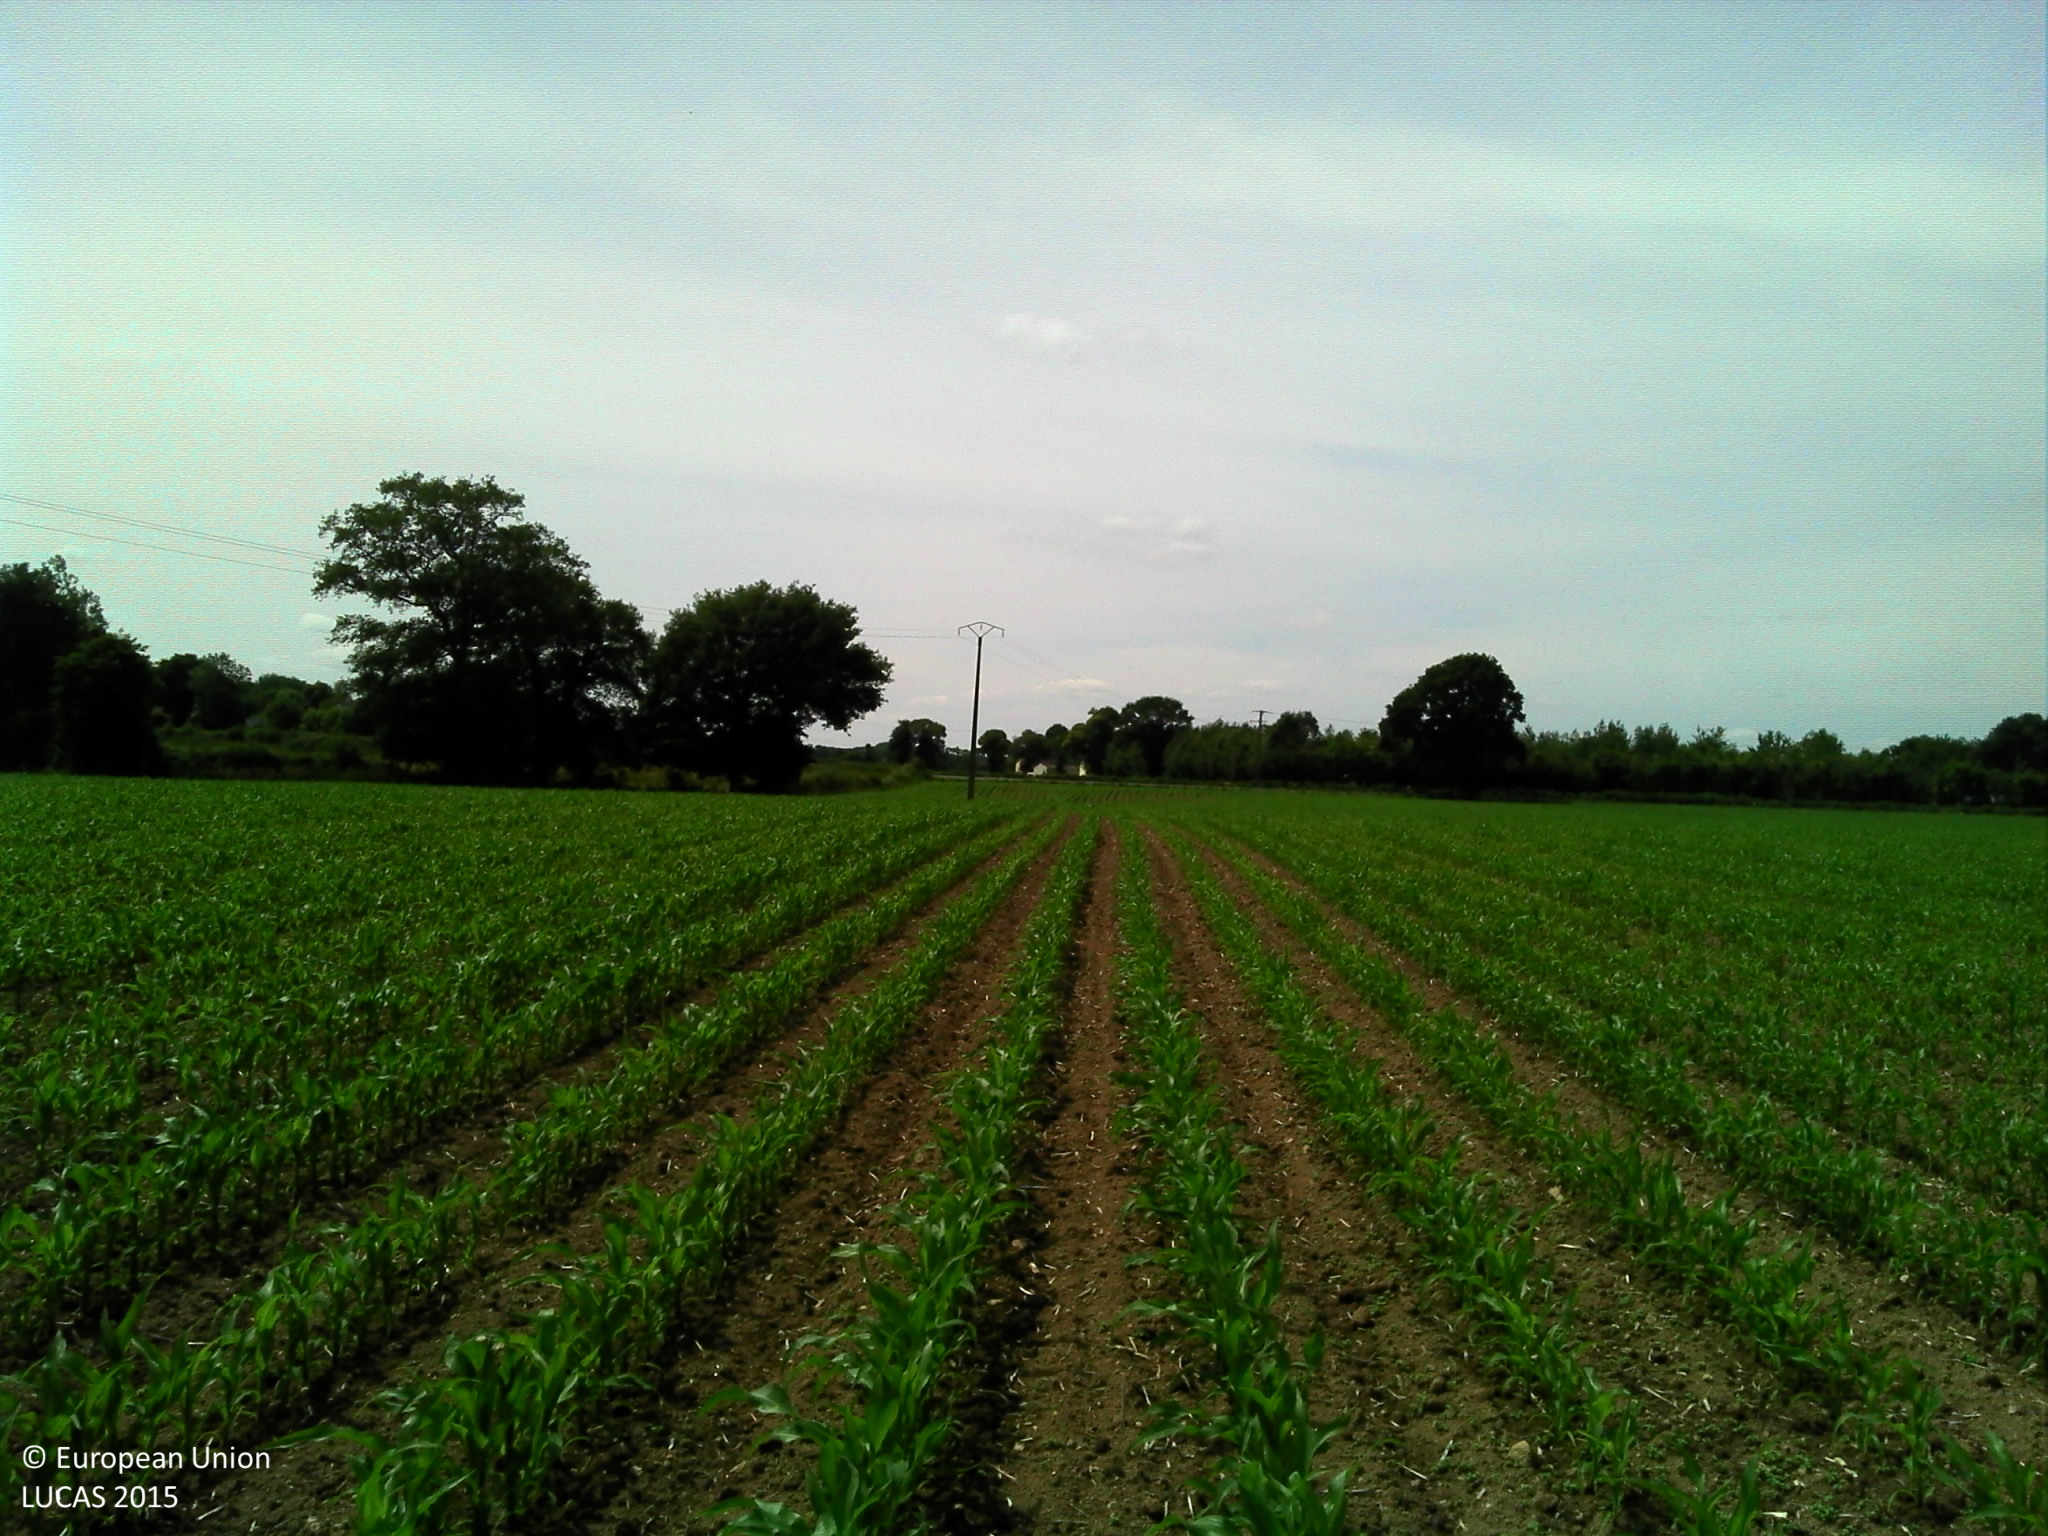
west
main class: Cropland
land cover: Maize
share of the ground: 25 - 50 %
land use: Agriculture (excluding fallow land and kitchen gardens)
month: June
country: FR
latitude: 48.3257
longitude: -1.5247
